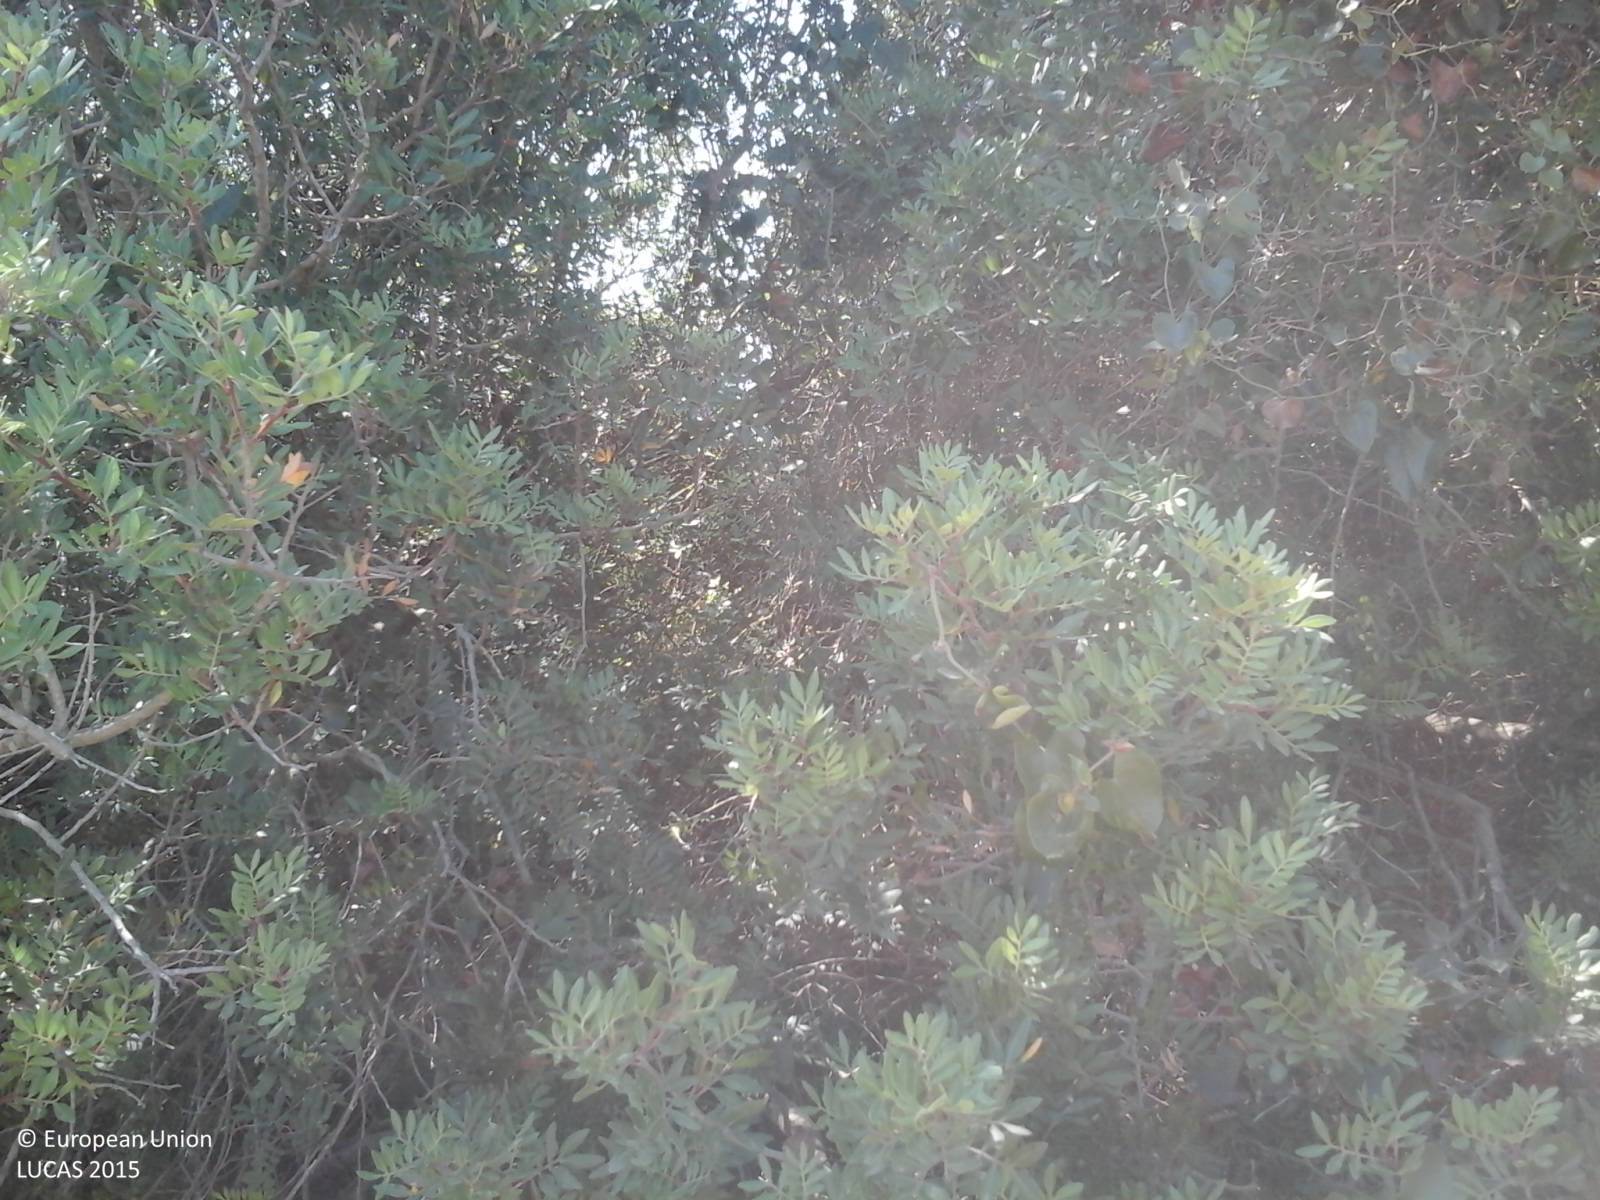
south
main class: Cropland
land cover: Temporary grasslands
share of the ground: > 75 %
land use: Agriculture (excluding fallow land and kitchen gardens)
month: July
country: IT
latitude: 40.9172
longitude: 9.4446
